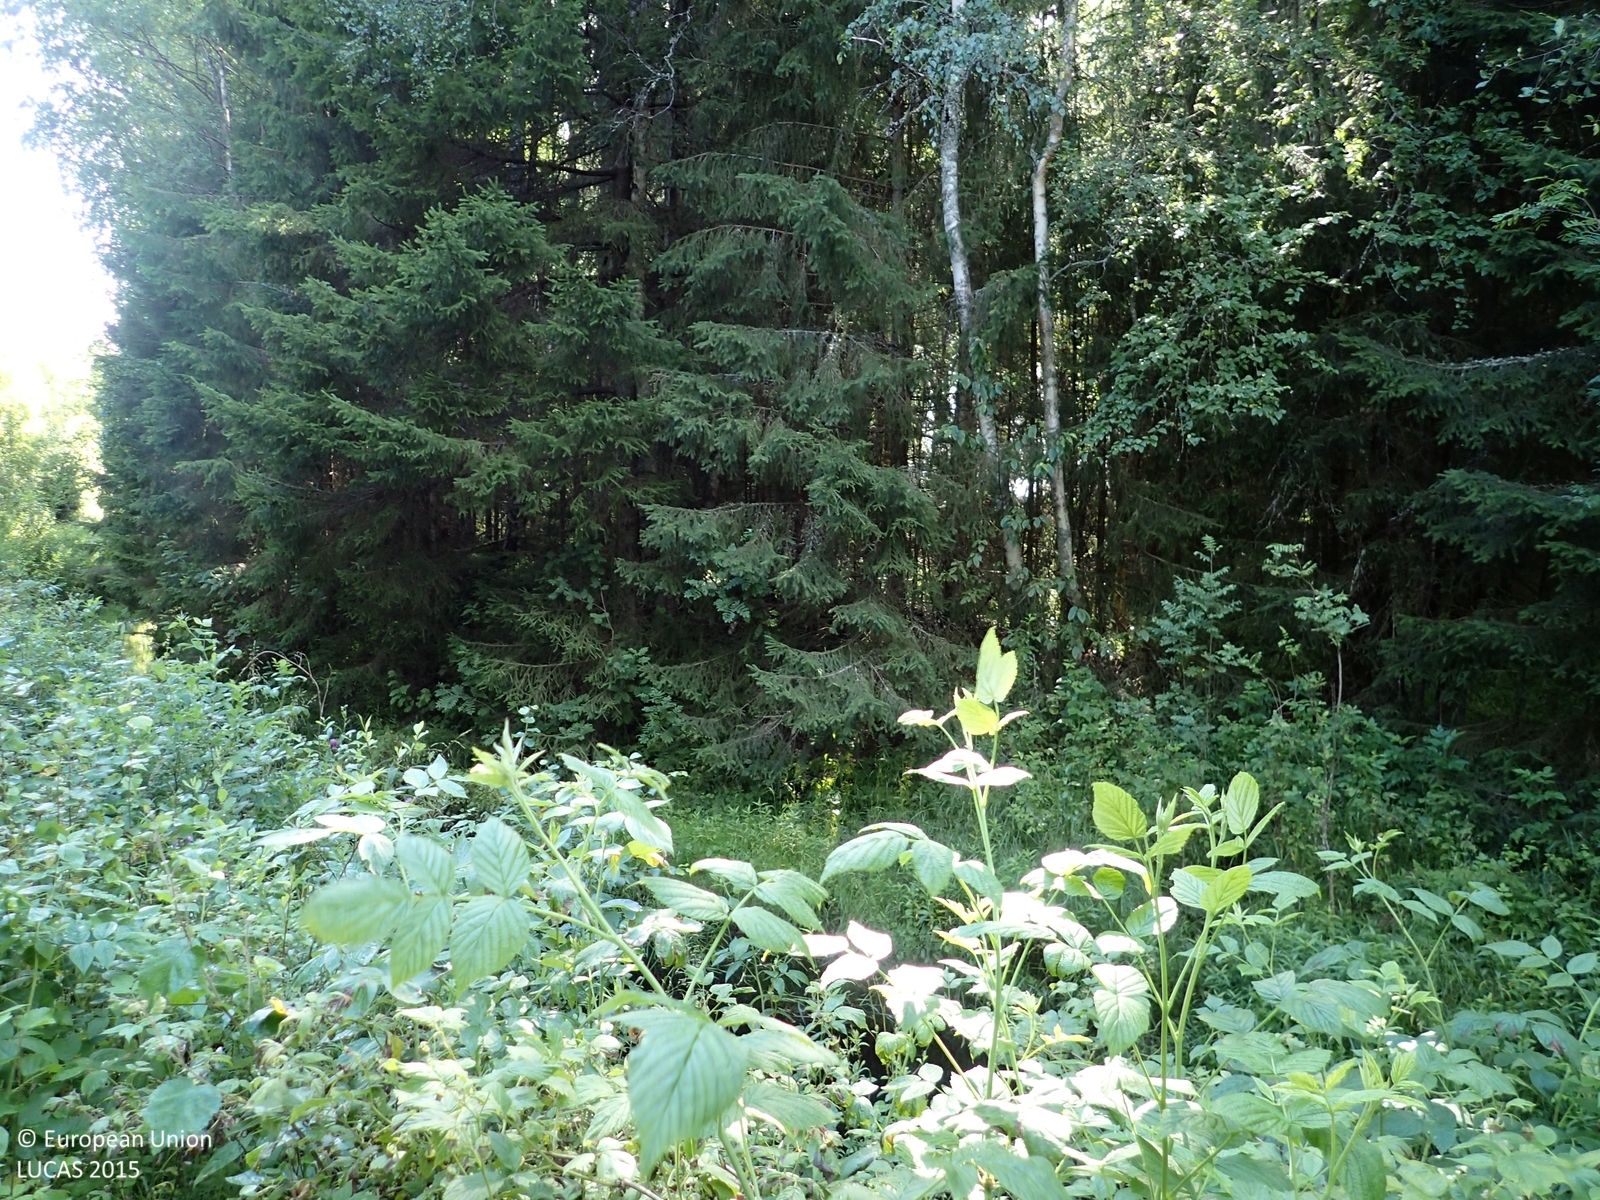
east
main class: Woodland
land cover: Broadleaved woodland
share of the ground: 25 - 50 %
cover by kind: herbaceous plants 75 %, broadleaved forest trees 25 %
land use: Forestry
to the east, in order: Broadleaved woodland; Ditches and canals; Grassland with sparse tree/shrub cover; Electric lines; Grassland with sparse tree/shrub cover; Spruce dominated mixed woodland
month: August
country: FI
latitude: 62.9676
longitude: 21.8172
